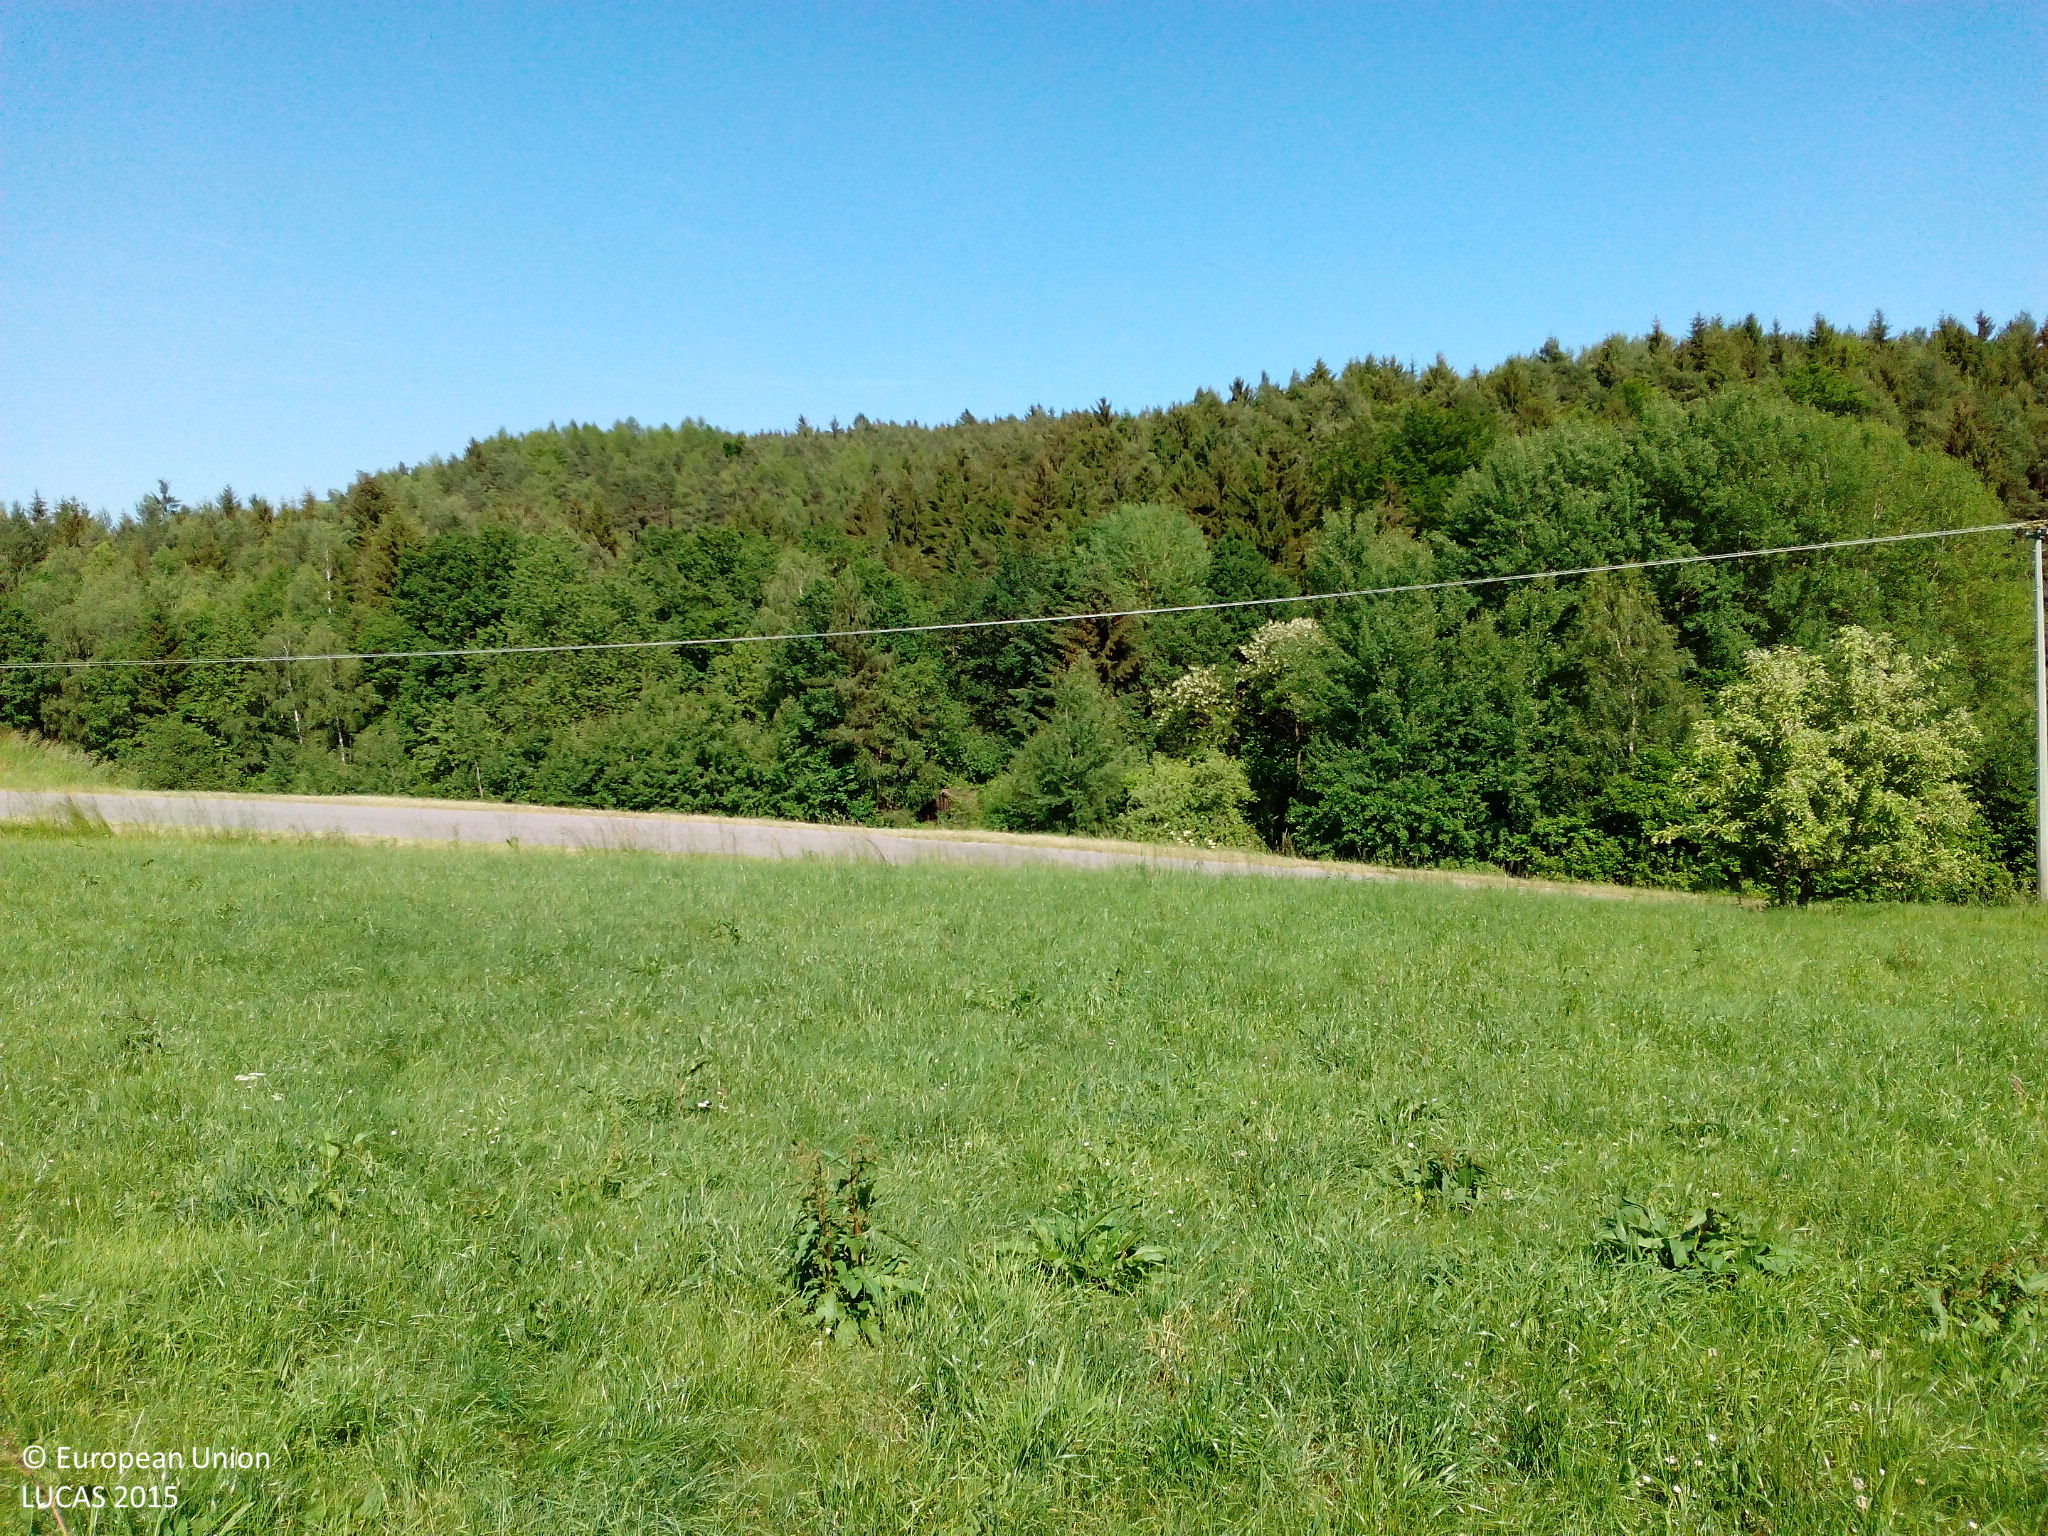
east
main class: Grassland
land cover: Grassland without tree/shrub cover
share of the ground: > 75 %
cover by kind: herbaceous plants 100 %
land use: Agriculture (excluding fallow land and kitchen gardens)
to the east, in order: Grassland without tree/shrub cover; Grass margins; Ditches and canals; Paved roads, cycling and walking lanes; Grassland without tree/shrub cover; Electric lines; Grassland without tree/shrub cover; Spruce dominated mixed woodland; Ditches and canals; Tracks; Rivers and streams; Spontaneously vegetated surfaces; Spruce dominated mixed woodland; Tracks; Other coniferous woodland
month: June
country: DE
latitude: 49.2767
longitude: 12.4324
